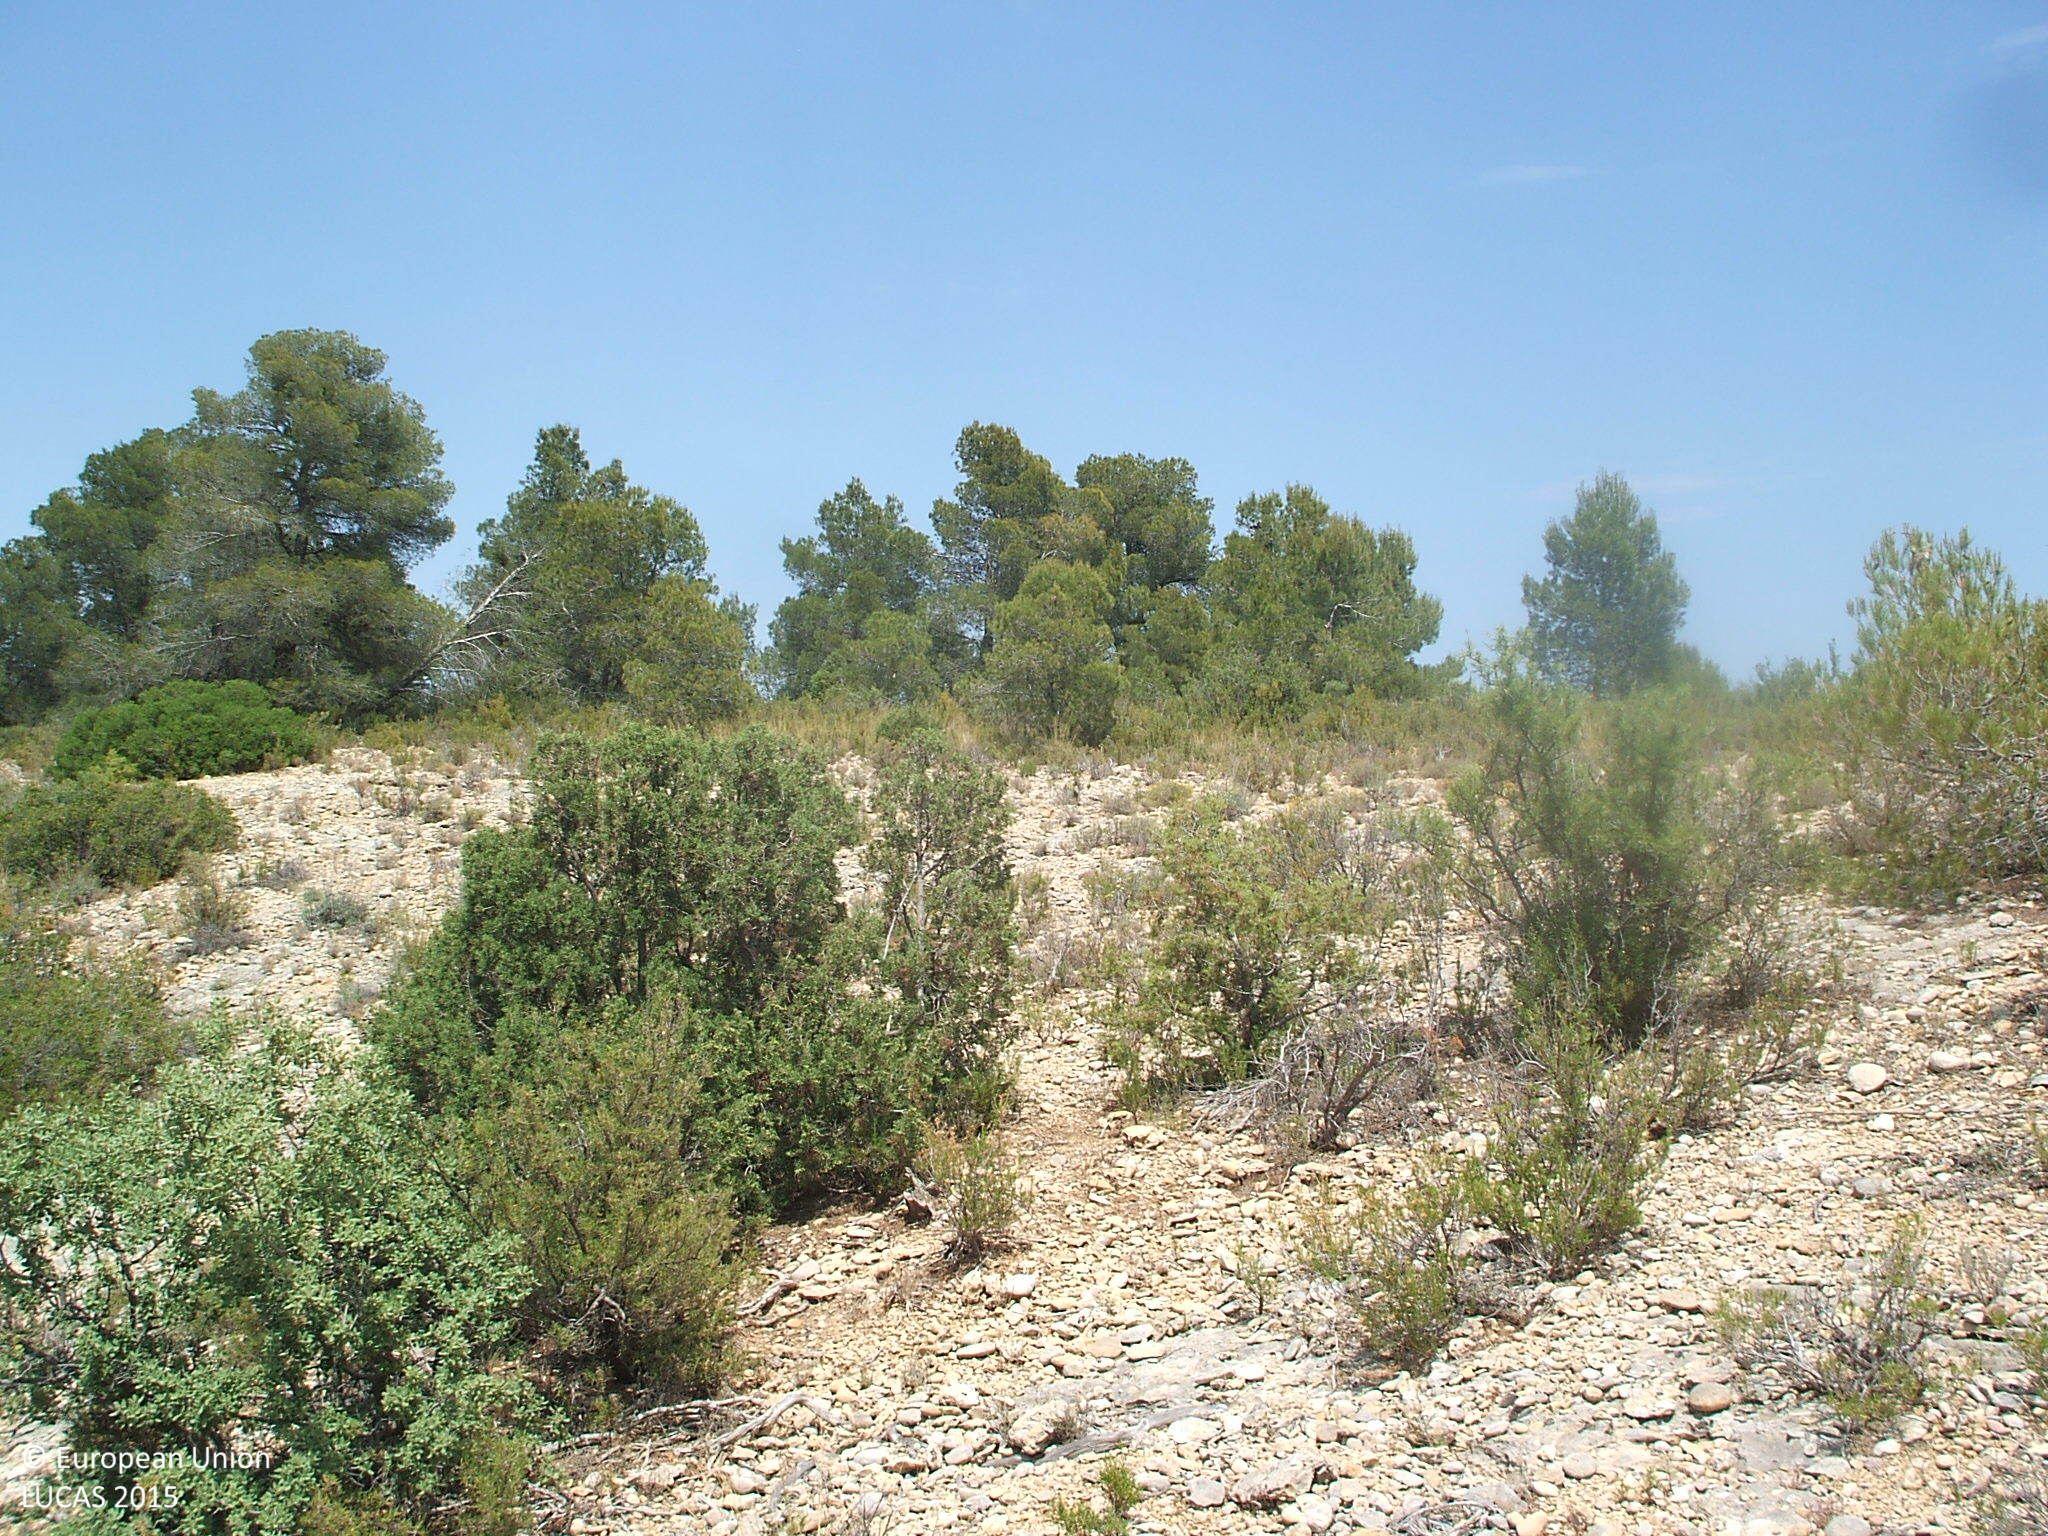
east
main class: Shrubland
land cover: Shrubland with sparse tree cover
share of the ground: 25 - 50 %
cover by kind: consolidated bare surface 75 %, shrubs 20 %, coniferous forest trees 5 %
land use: Semi-natural and natural areas not in use
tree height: < 5 m
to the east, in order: Shrubland with sparse tree cover; Nuts trees; Grass margins; Dry stone walls; Nuts trees; Shrubland with sparse tree cover; Tracks; Shrubland without tree cover; Rock outcrops; Pine dominated coniferous woodland; Rock outcrops; Pine dominated coniferous woodland; Tracks; Pine dominated coniferous woodland; Tracks; Shrubland with sparse tree cover; Nuts trees
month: June
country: ES
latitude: 40.8913
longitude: -0.1104
